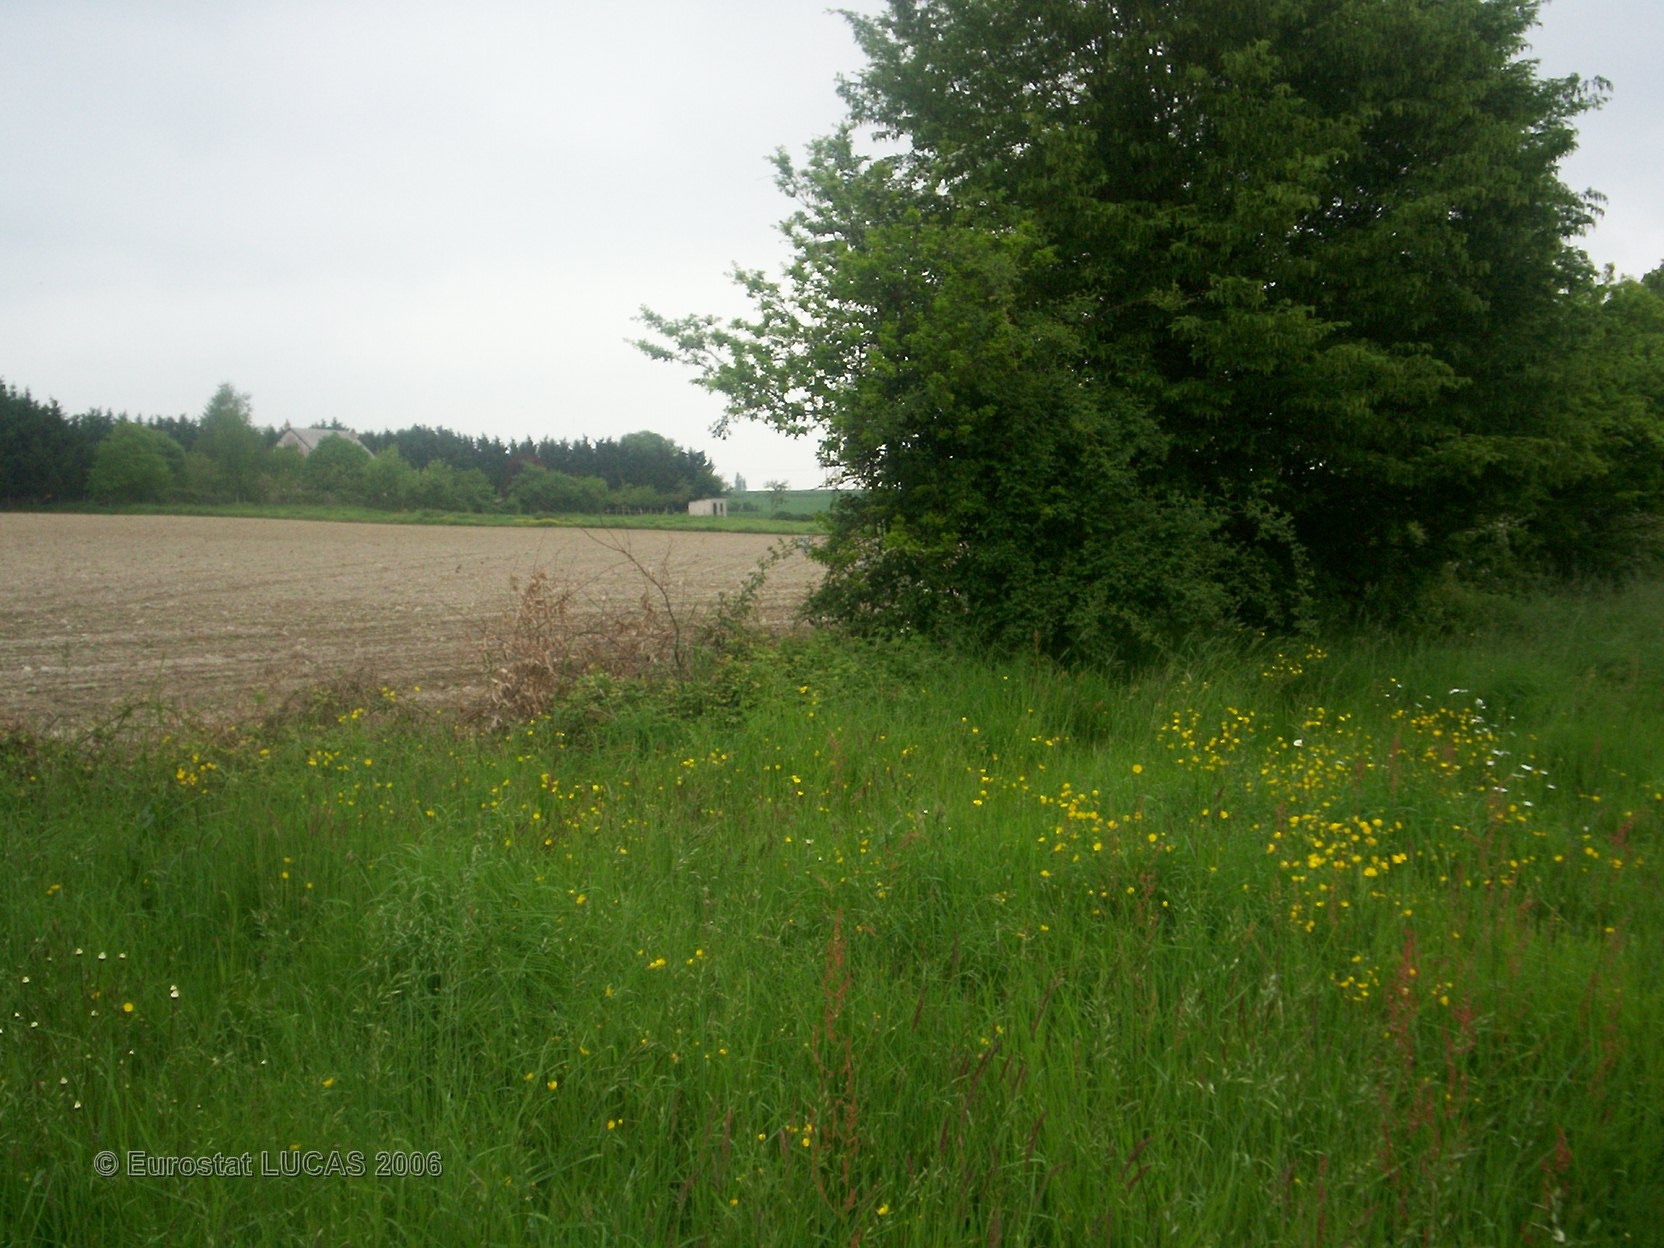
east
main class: Grassland
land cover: Grassland without tree/shrub cover
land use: Agriculture (excluding fallow land and kitchen gardens)
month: May
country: FR
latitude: 47.8264
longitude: 0.4527
